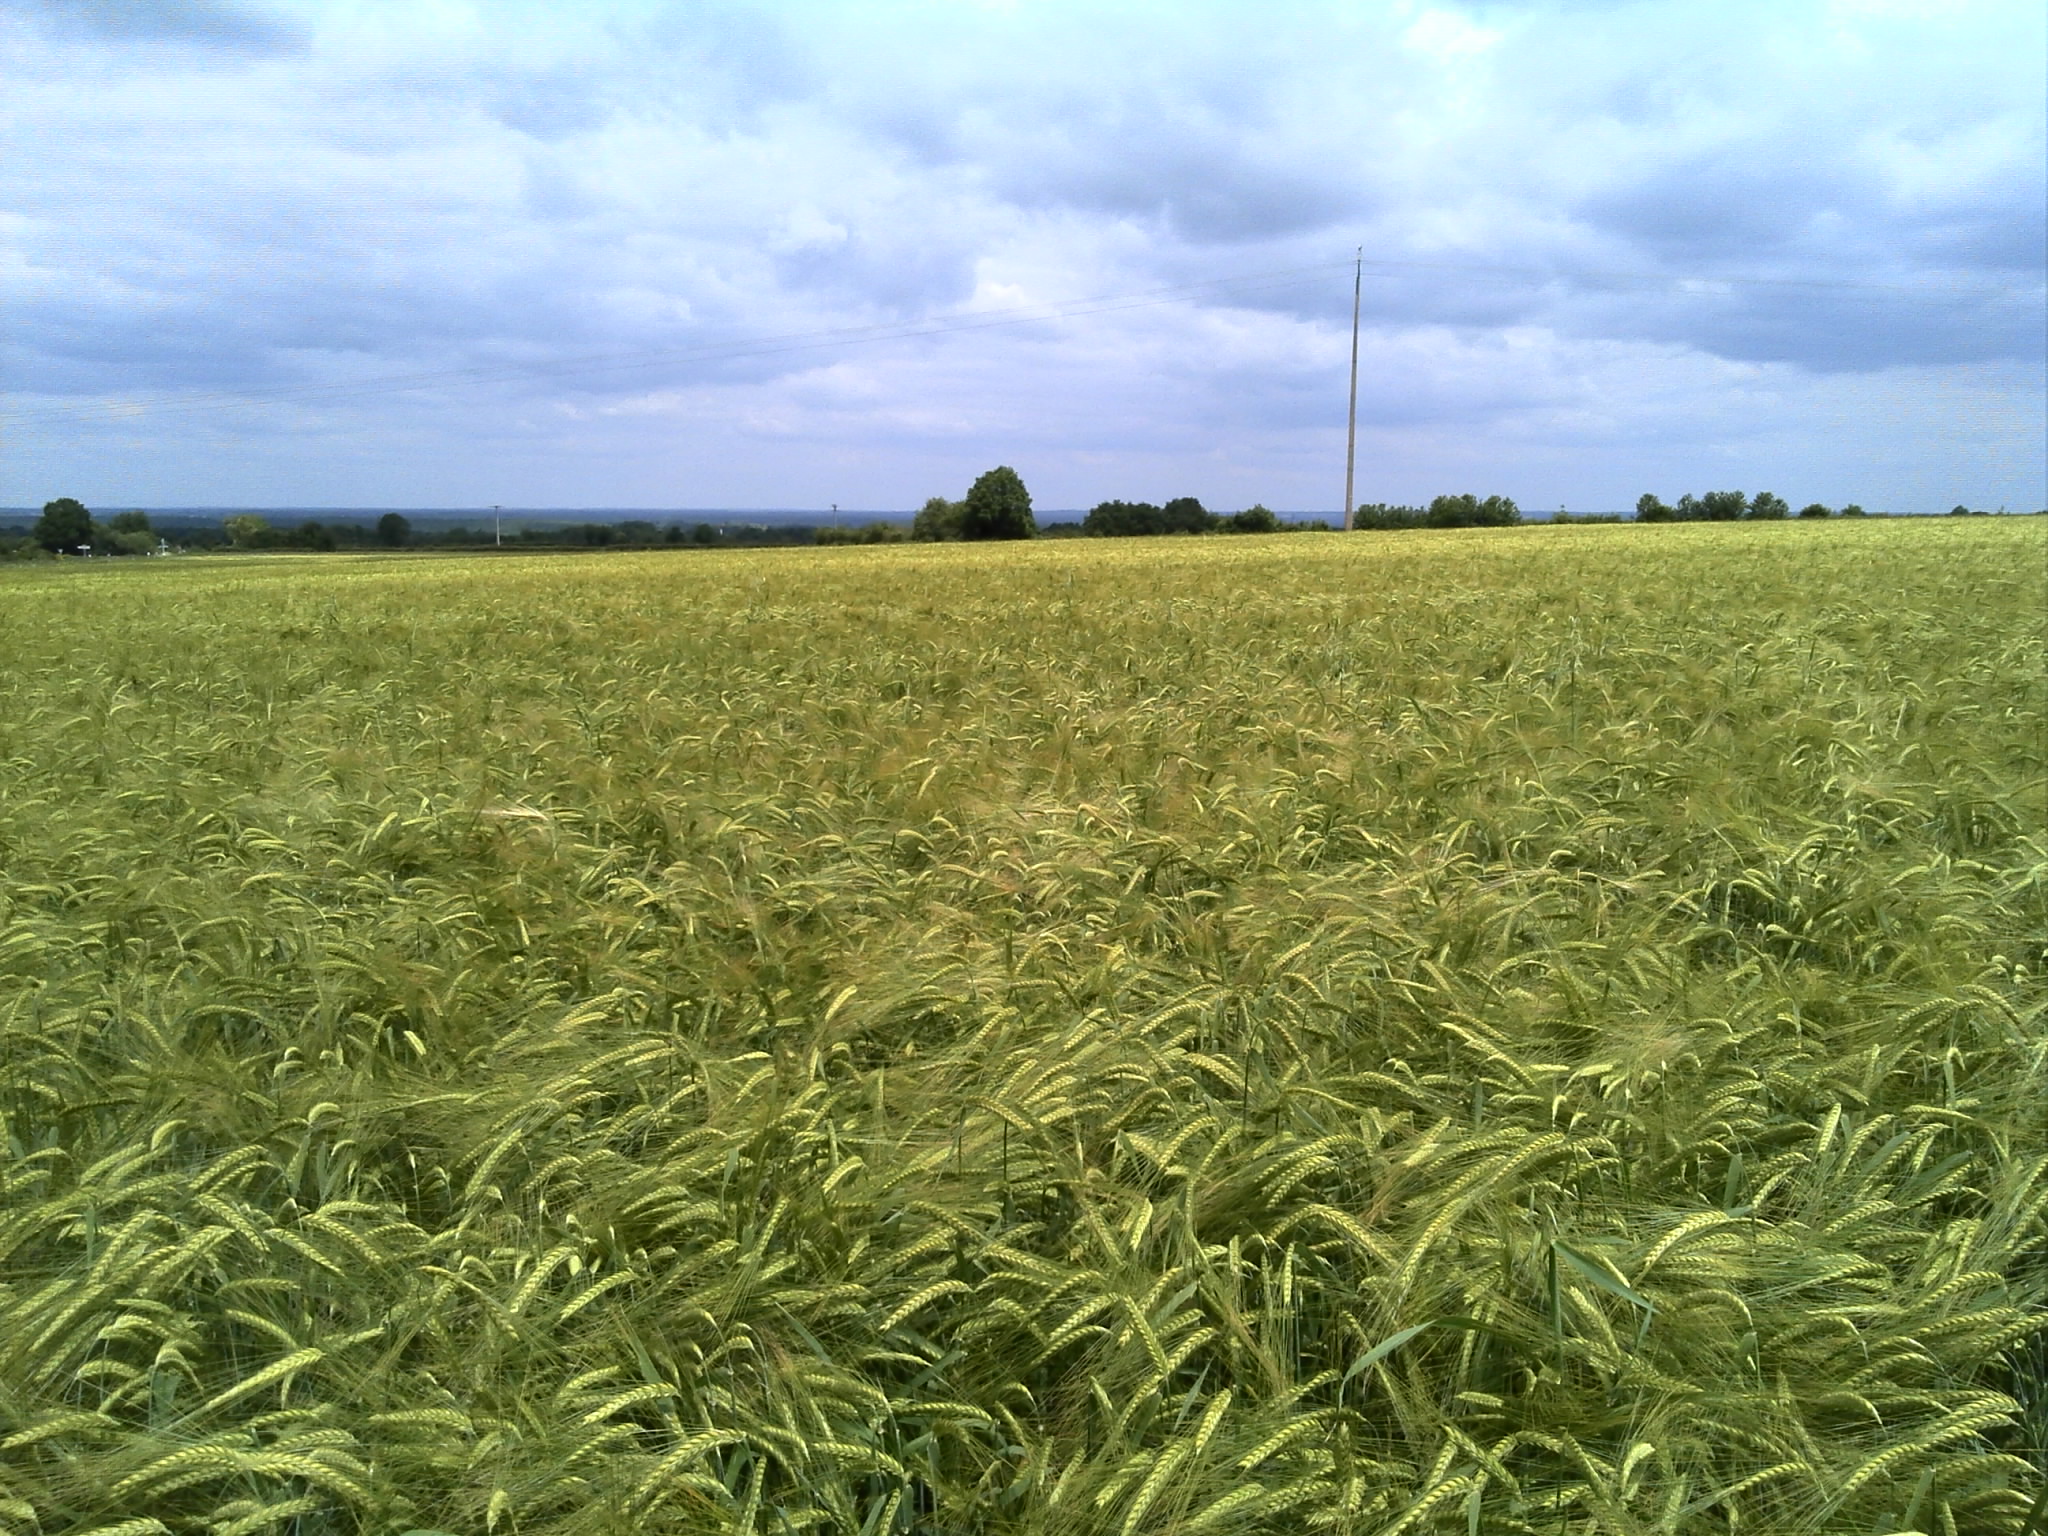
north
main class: Cropland
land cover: Barley
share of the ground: > 75 %
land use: Agriculture (excluding fallow land and kitchen gardens)
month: May
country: FR
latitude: 46.5815
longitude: 1.5990
